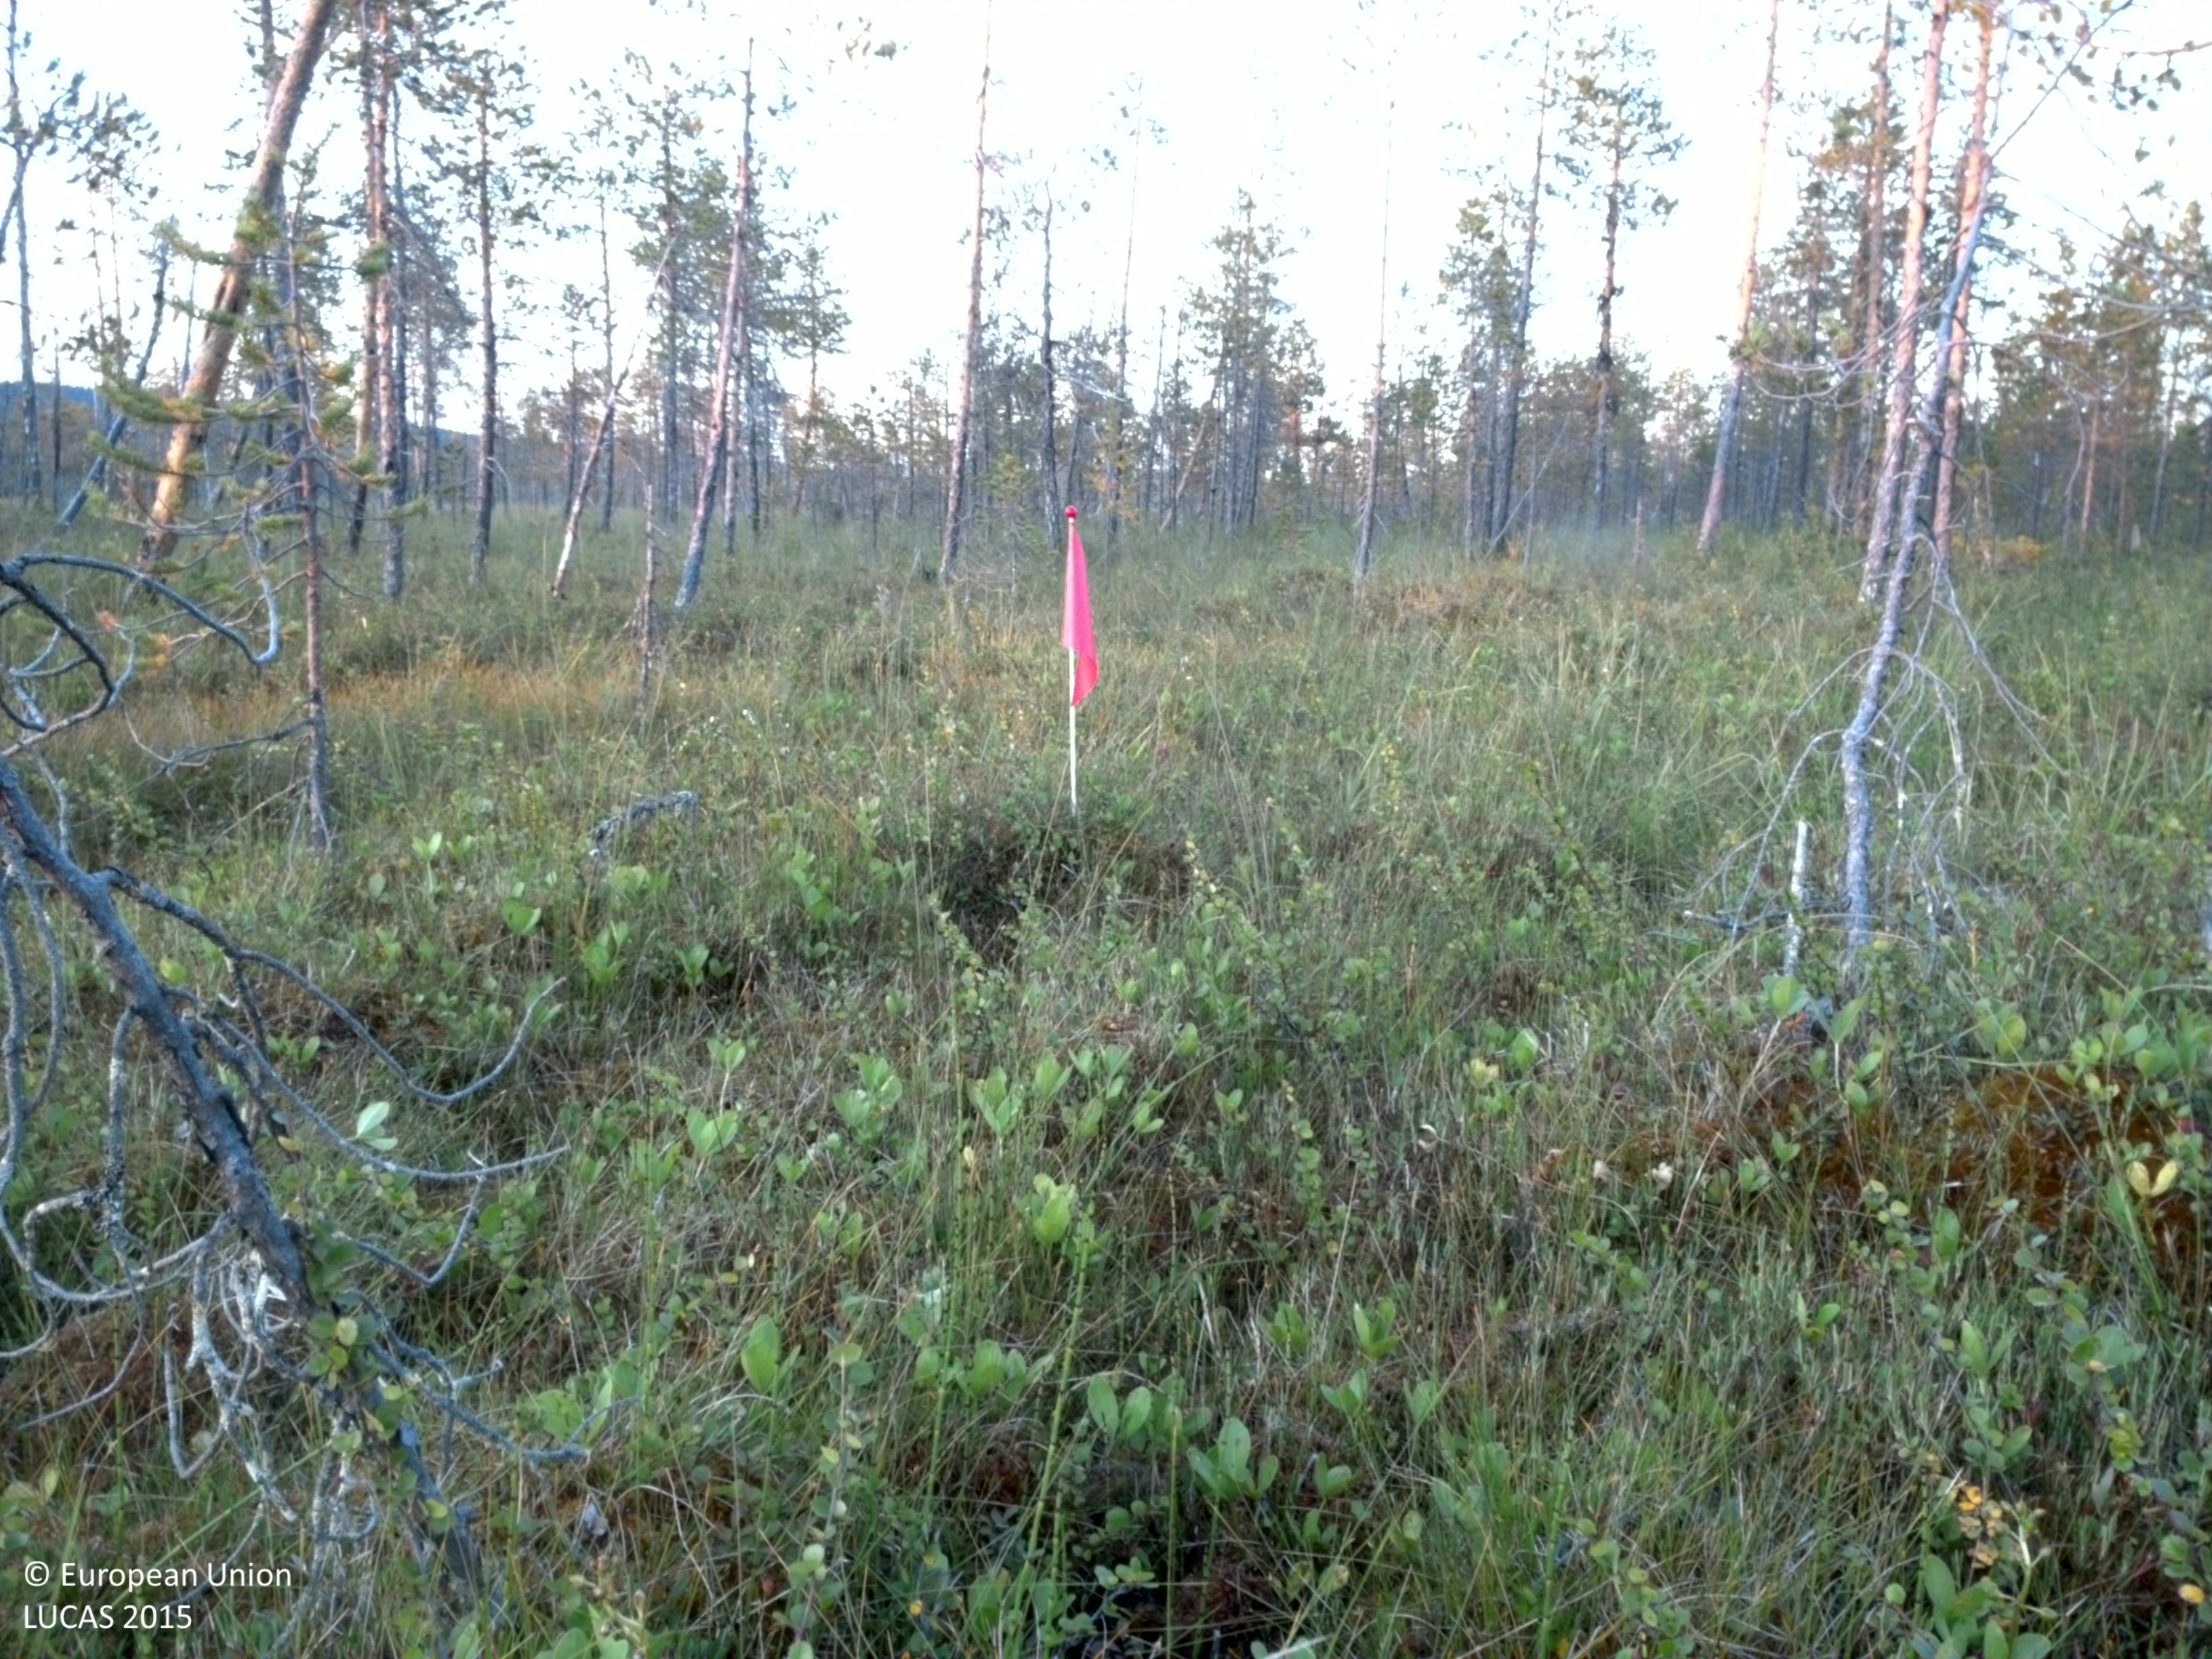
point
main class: Woodland
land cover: Pine dominated coniferous woodland
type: mire and swamp forests
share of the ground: 10 - 25 %
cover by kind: shrubs 55 %, coniferous forest trees 20 %, lichens and mosses 15 %, herbaceous plants 10 %
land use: Semi-natural and natural areas not in use
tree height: > 5 m
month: August
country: SE
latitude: 66.6124
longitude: 19.1389
